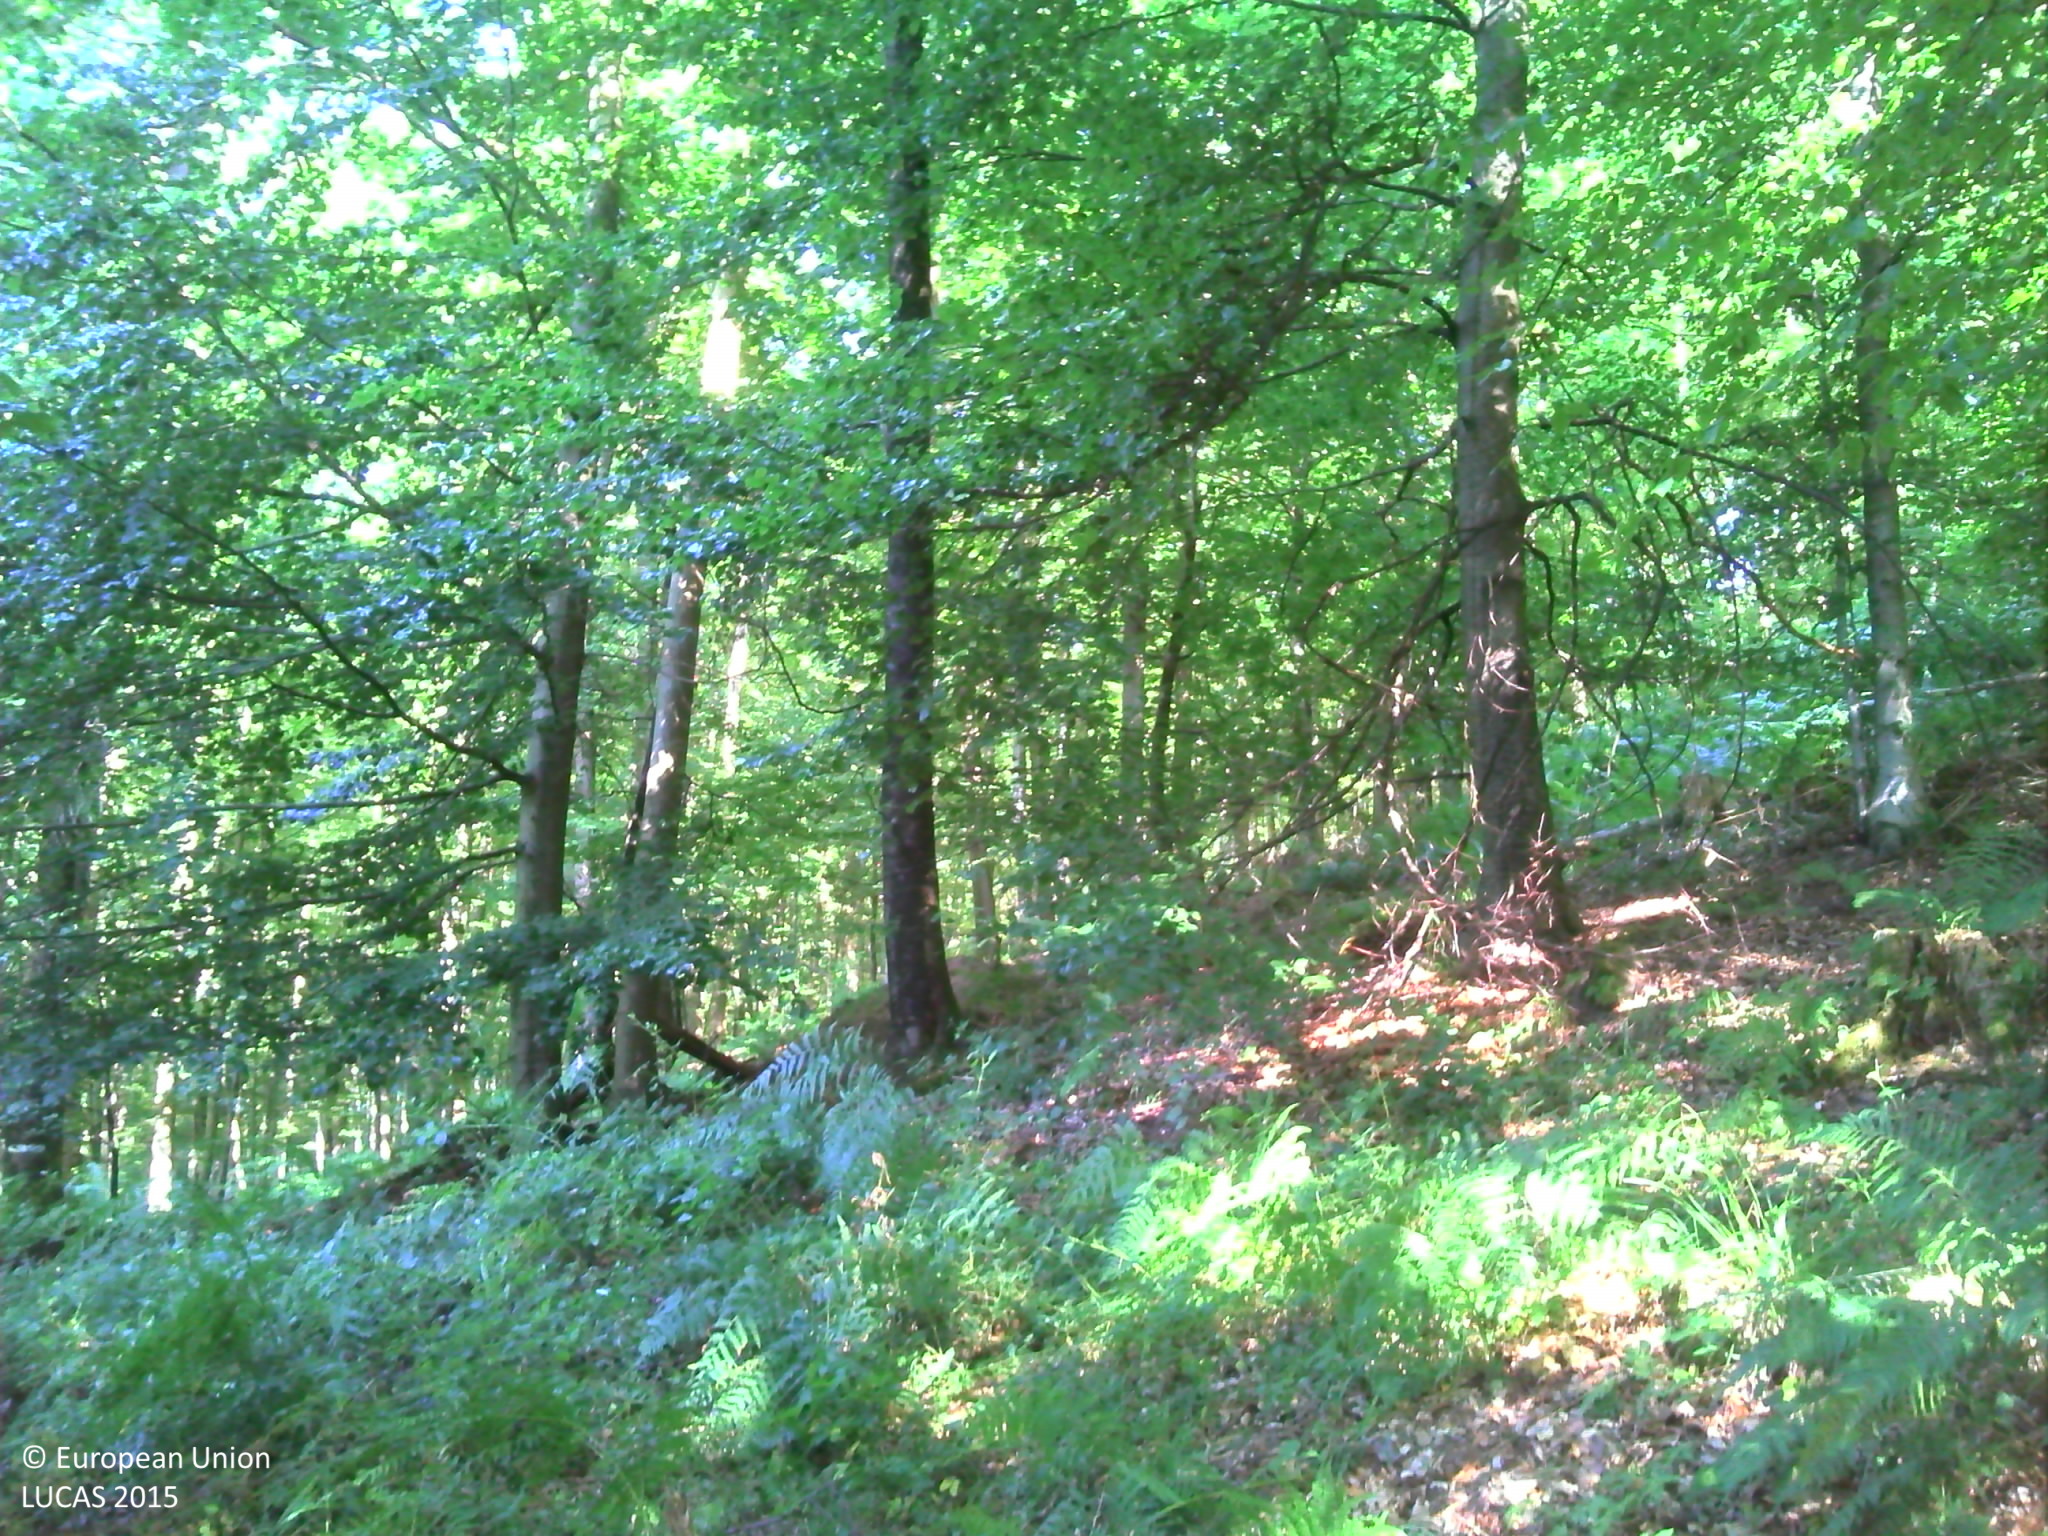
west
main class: Woodland
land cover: Broadleaved woodland
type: beech forest
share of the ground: > 75 %
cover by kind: broadleaved forest trees 95 %, coniferous forest trees 5 %
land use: Forestry
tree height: > 5 m
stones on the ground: < 10 %
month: July
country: FR
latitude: 48.7851
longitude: 7.3194
